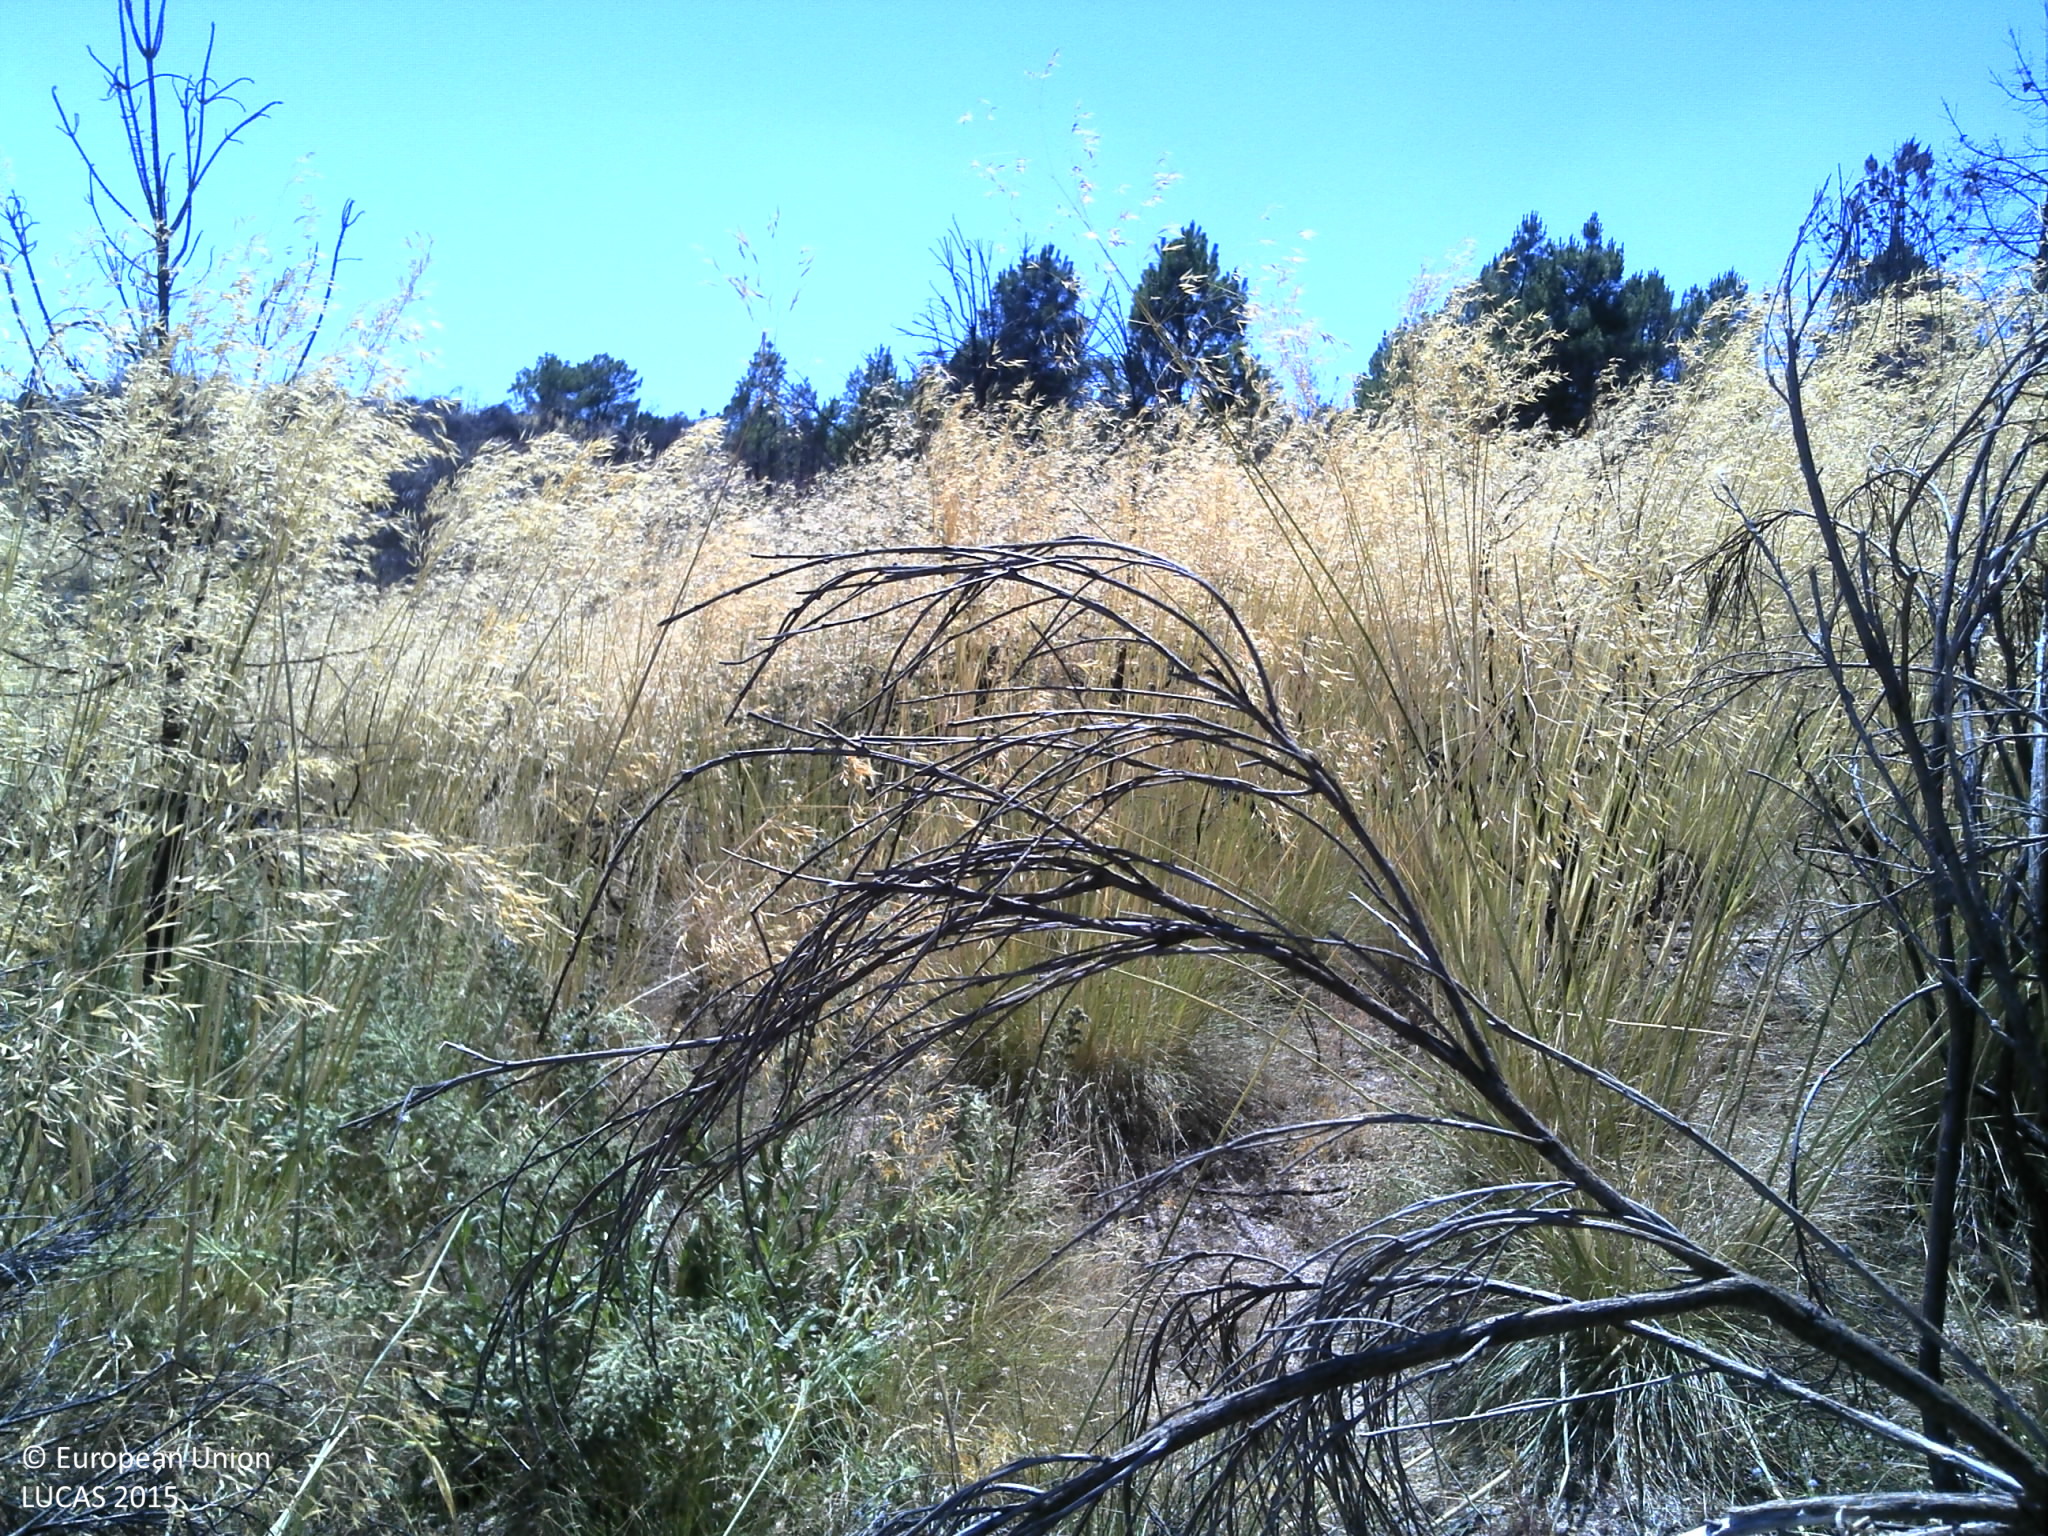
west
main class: Grassland
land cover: Spontaneously vegetated surfaces
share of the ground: 50 - 75 %
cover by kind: herbaceous plants 60 %, unconsolidated bare surface 40 %
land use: Semi-natural and natural areas not in use
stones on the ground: 10 - 25 %
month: June
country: PT
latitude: 40.7350
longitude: -7.3641
